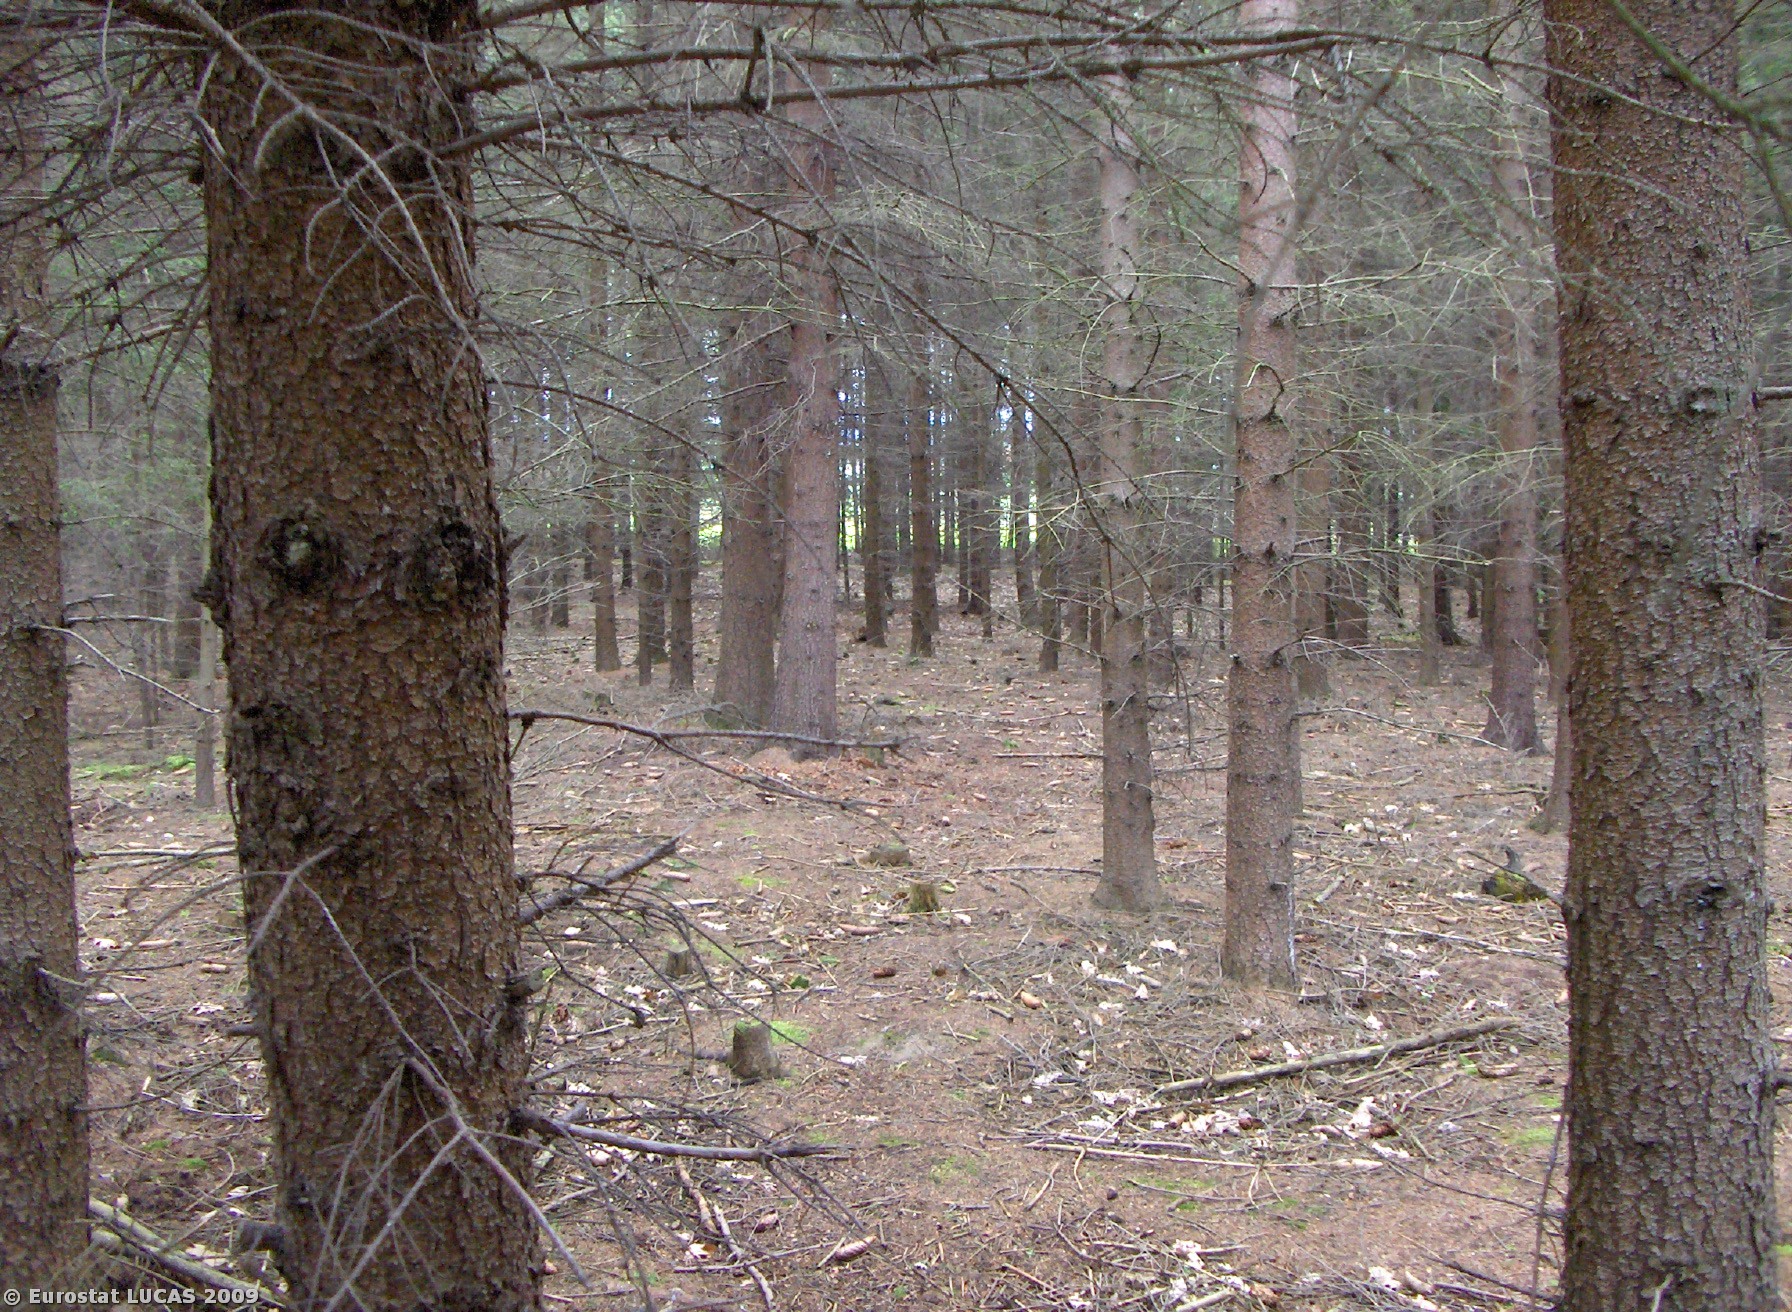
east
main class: Woodland
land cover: Coniferous woodland
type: hemiboreal forest and nemoral coniferous forest and mixed broadleaved-coniferous forest
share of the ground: > 75 %
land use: Forestry
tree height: > 5 m
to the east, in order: Coniferous woodland; Tracks; Mixed woodland; Broadleaved woodland; Grassland without tree/shrub cover; Ditches and canals; Railways; Shrubland without tree cover; Common wheat
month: June
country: CZ
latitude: 49.7993
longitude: 14.2386
